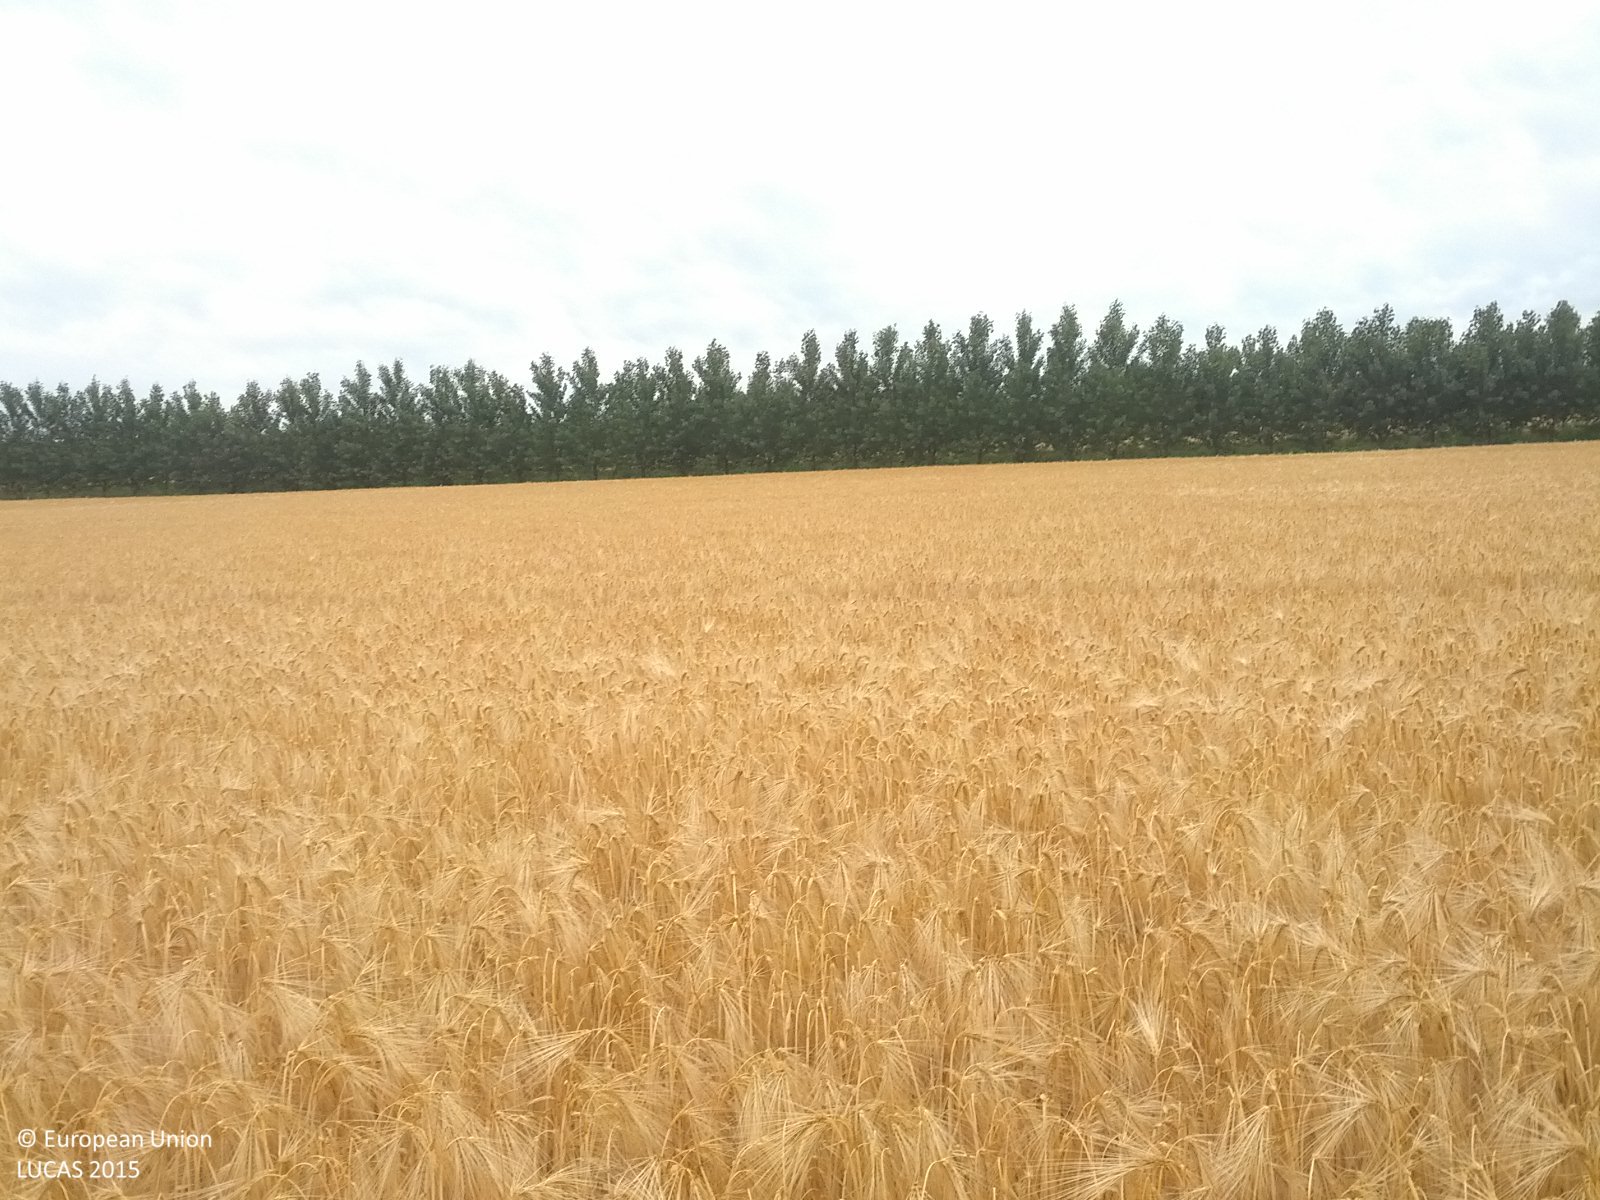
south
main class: Cropland
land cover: Barley
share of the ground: > 75 %
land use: Agriculture (excluding fallow land and kitchen gardens)
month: June
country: AT
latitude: 48.2607
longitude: 16.8906
